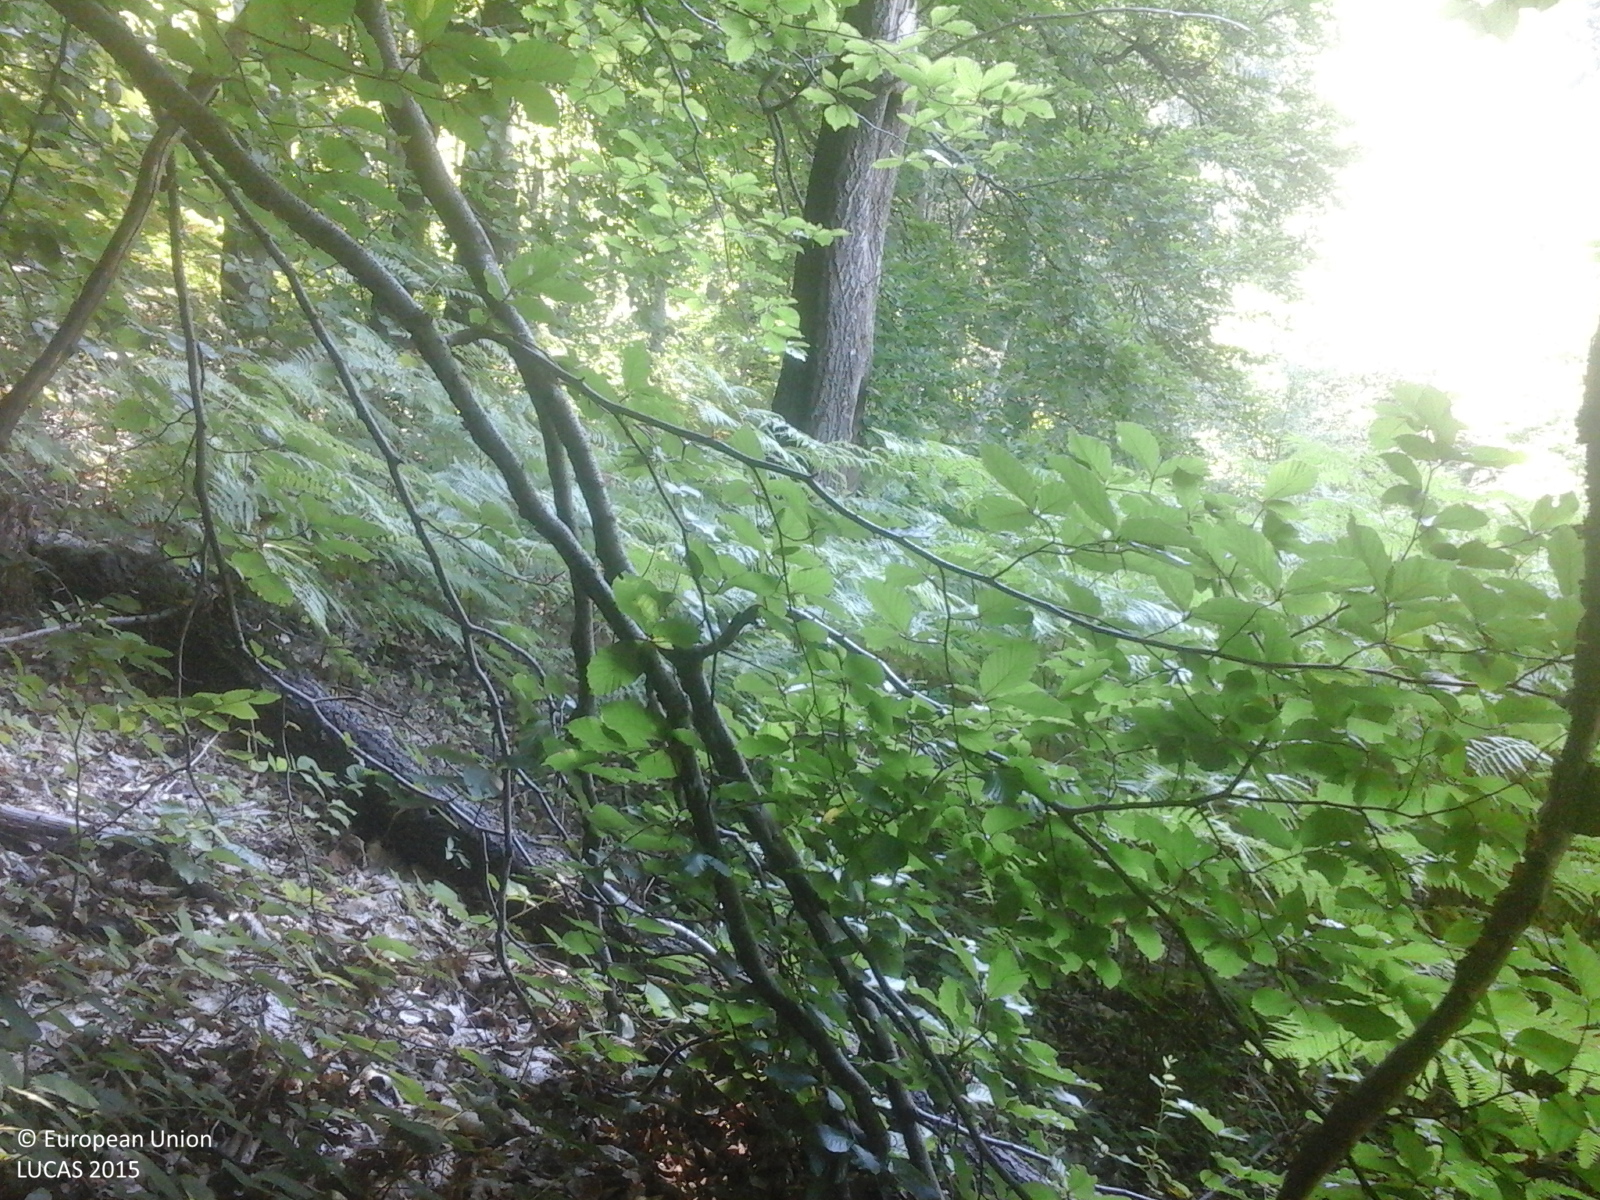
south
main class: Woodland
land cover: Broadleaved woodland
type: mesophytic deciduous forest
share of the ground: > 75 %
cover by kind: broadleaved forest trees 100 %
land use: Forestry
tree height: > 5 m
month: August
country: RO
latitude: 46.1471
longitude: 22.4648
